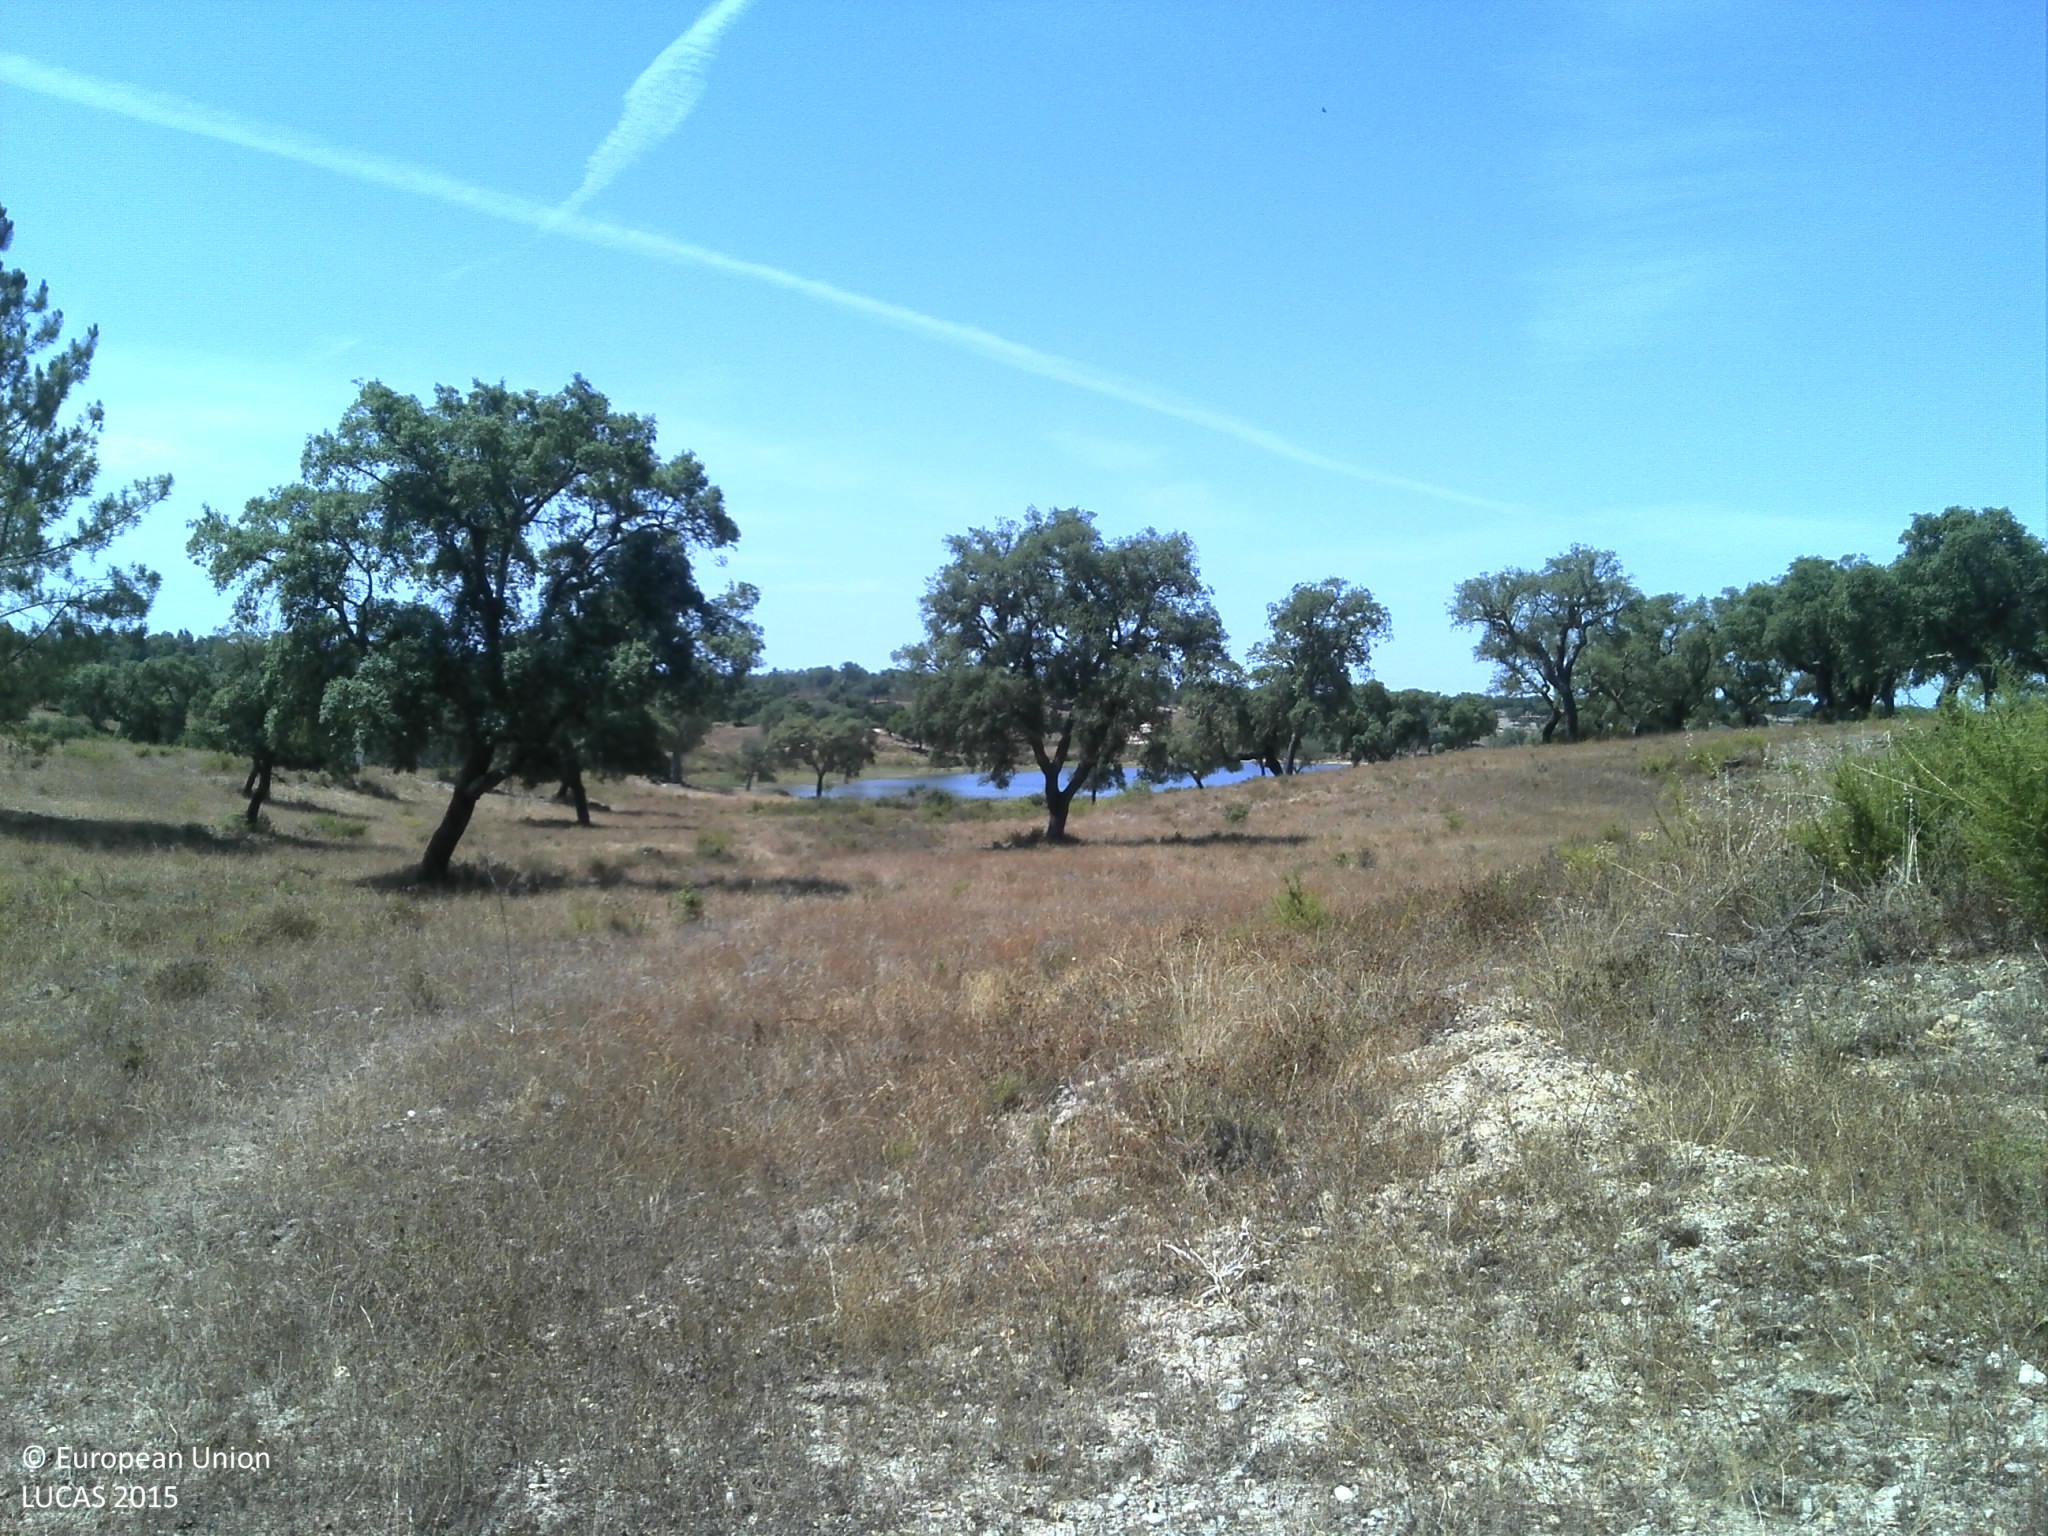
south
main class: Woodland
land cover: Broadleaved woodland
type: broadleaved evergreen forest
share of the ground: 10 - 25 %
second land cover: Grassland without tree/shrub cover
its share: 25 - 50 %
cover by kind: unconsolidated bare surface 55 %, herbaceous plants 25 %, broadleaved forest trees 15 %, shrubs 5 %
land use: Forestry
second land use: Agriculture (excluding fallow land and kitchen gardens)
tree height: > 5 m
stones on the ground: < 10 %
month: July
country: PT
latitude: 39.2130
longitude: -8.2075
